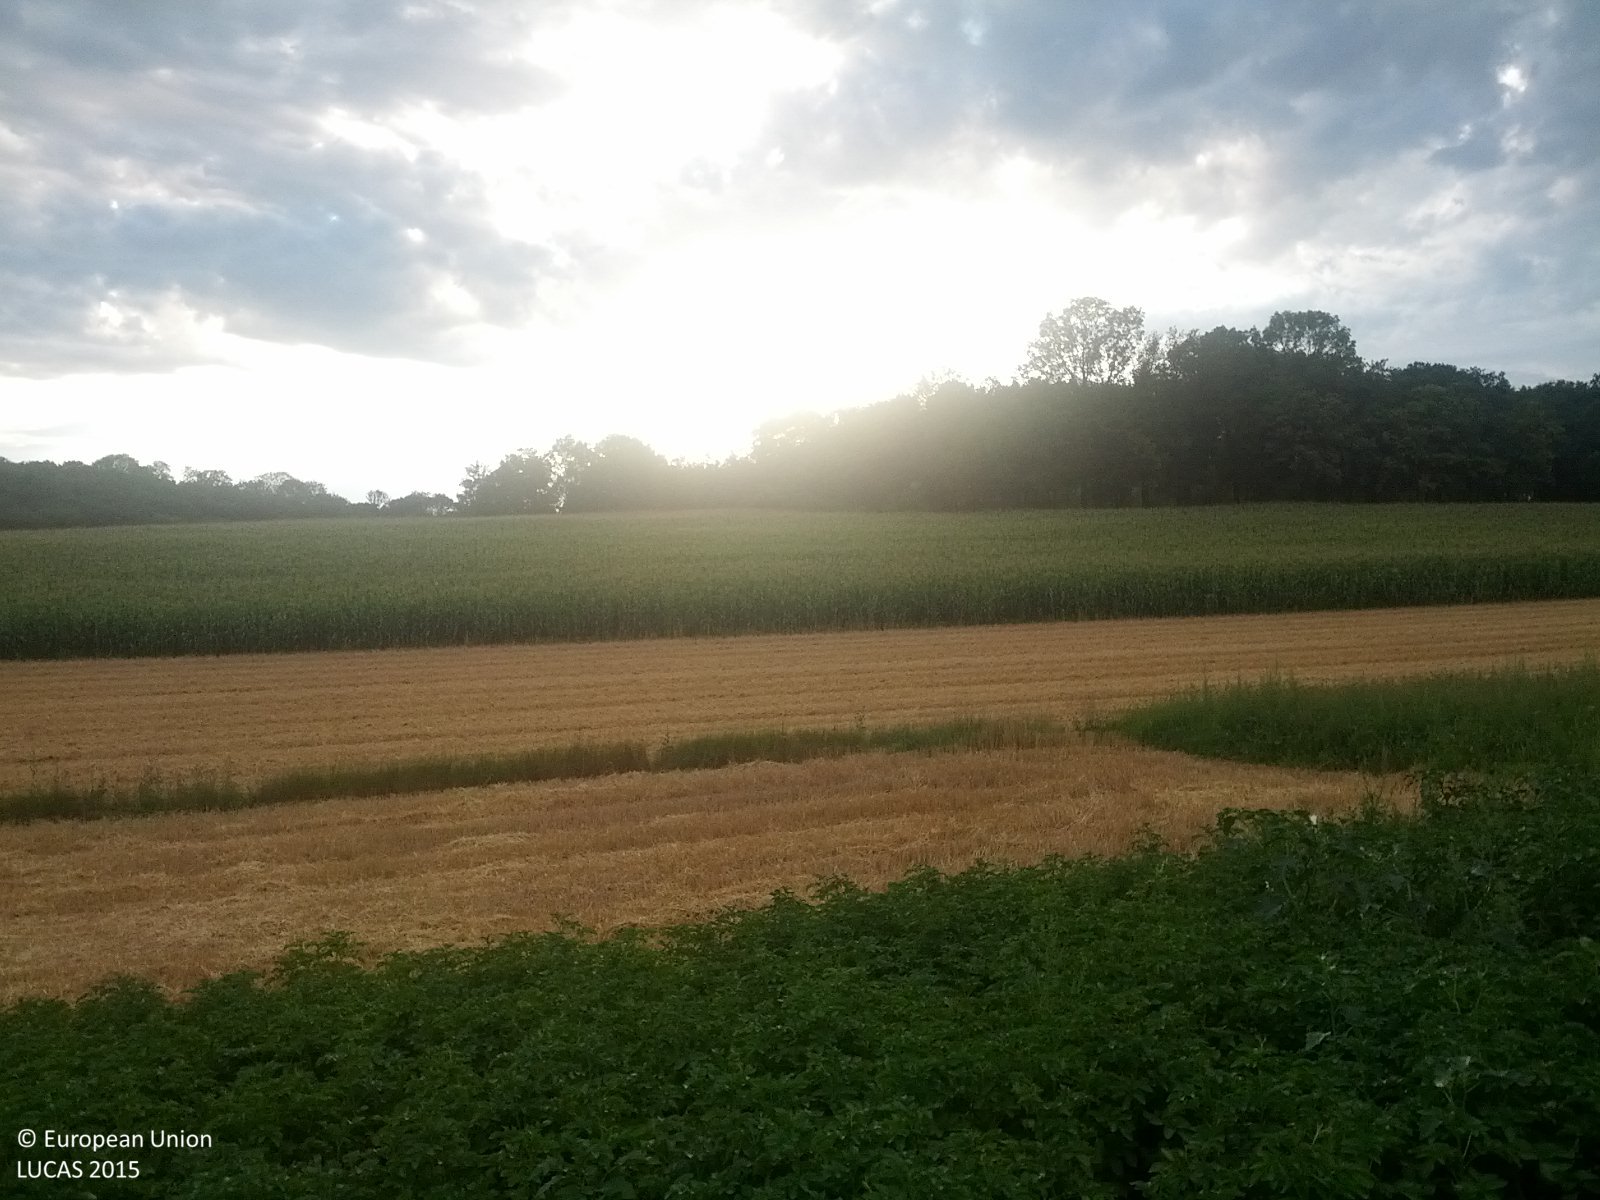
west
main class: Cropland
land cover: Potatoes
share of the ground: > 75 %
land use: Agriculture (excluding fallow land and kitchen gardens)
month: July
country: AT
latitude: 48.4931
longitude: 16.3247
